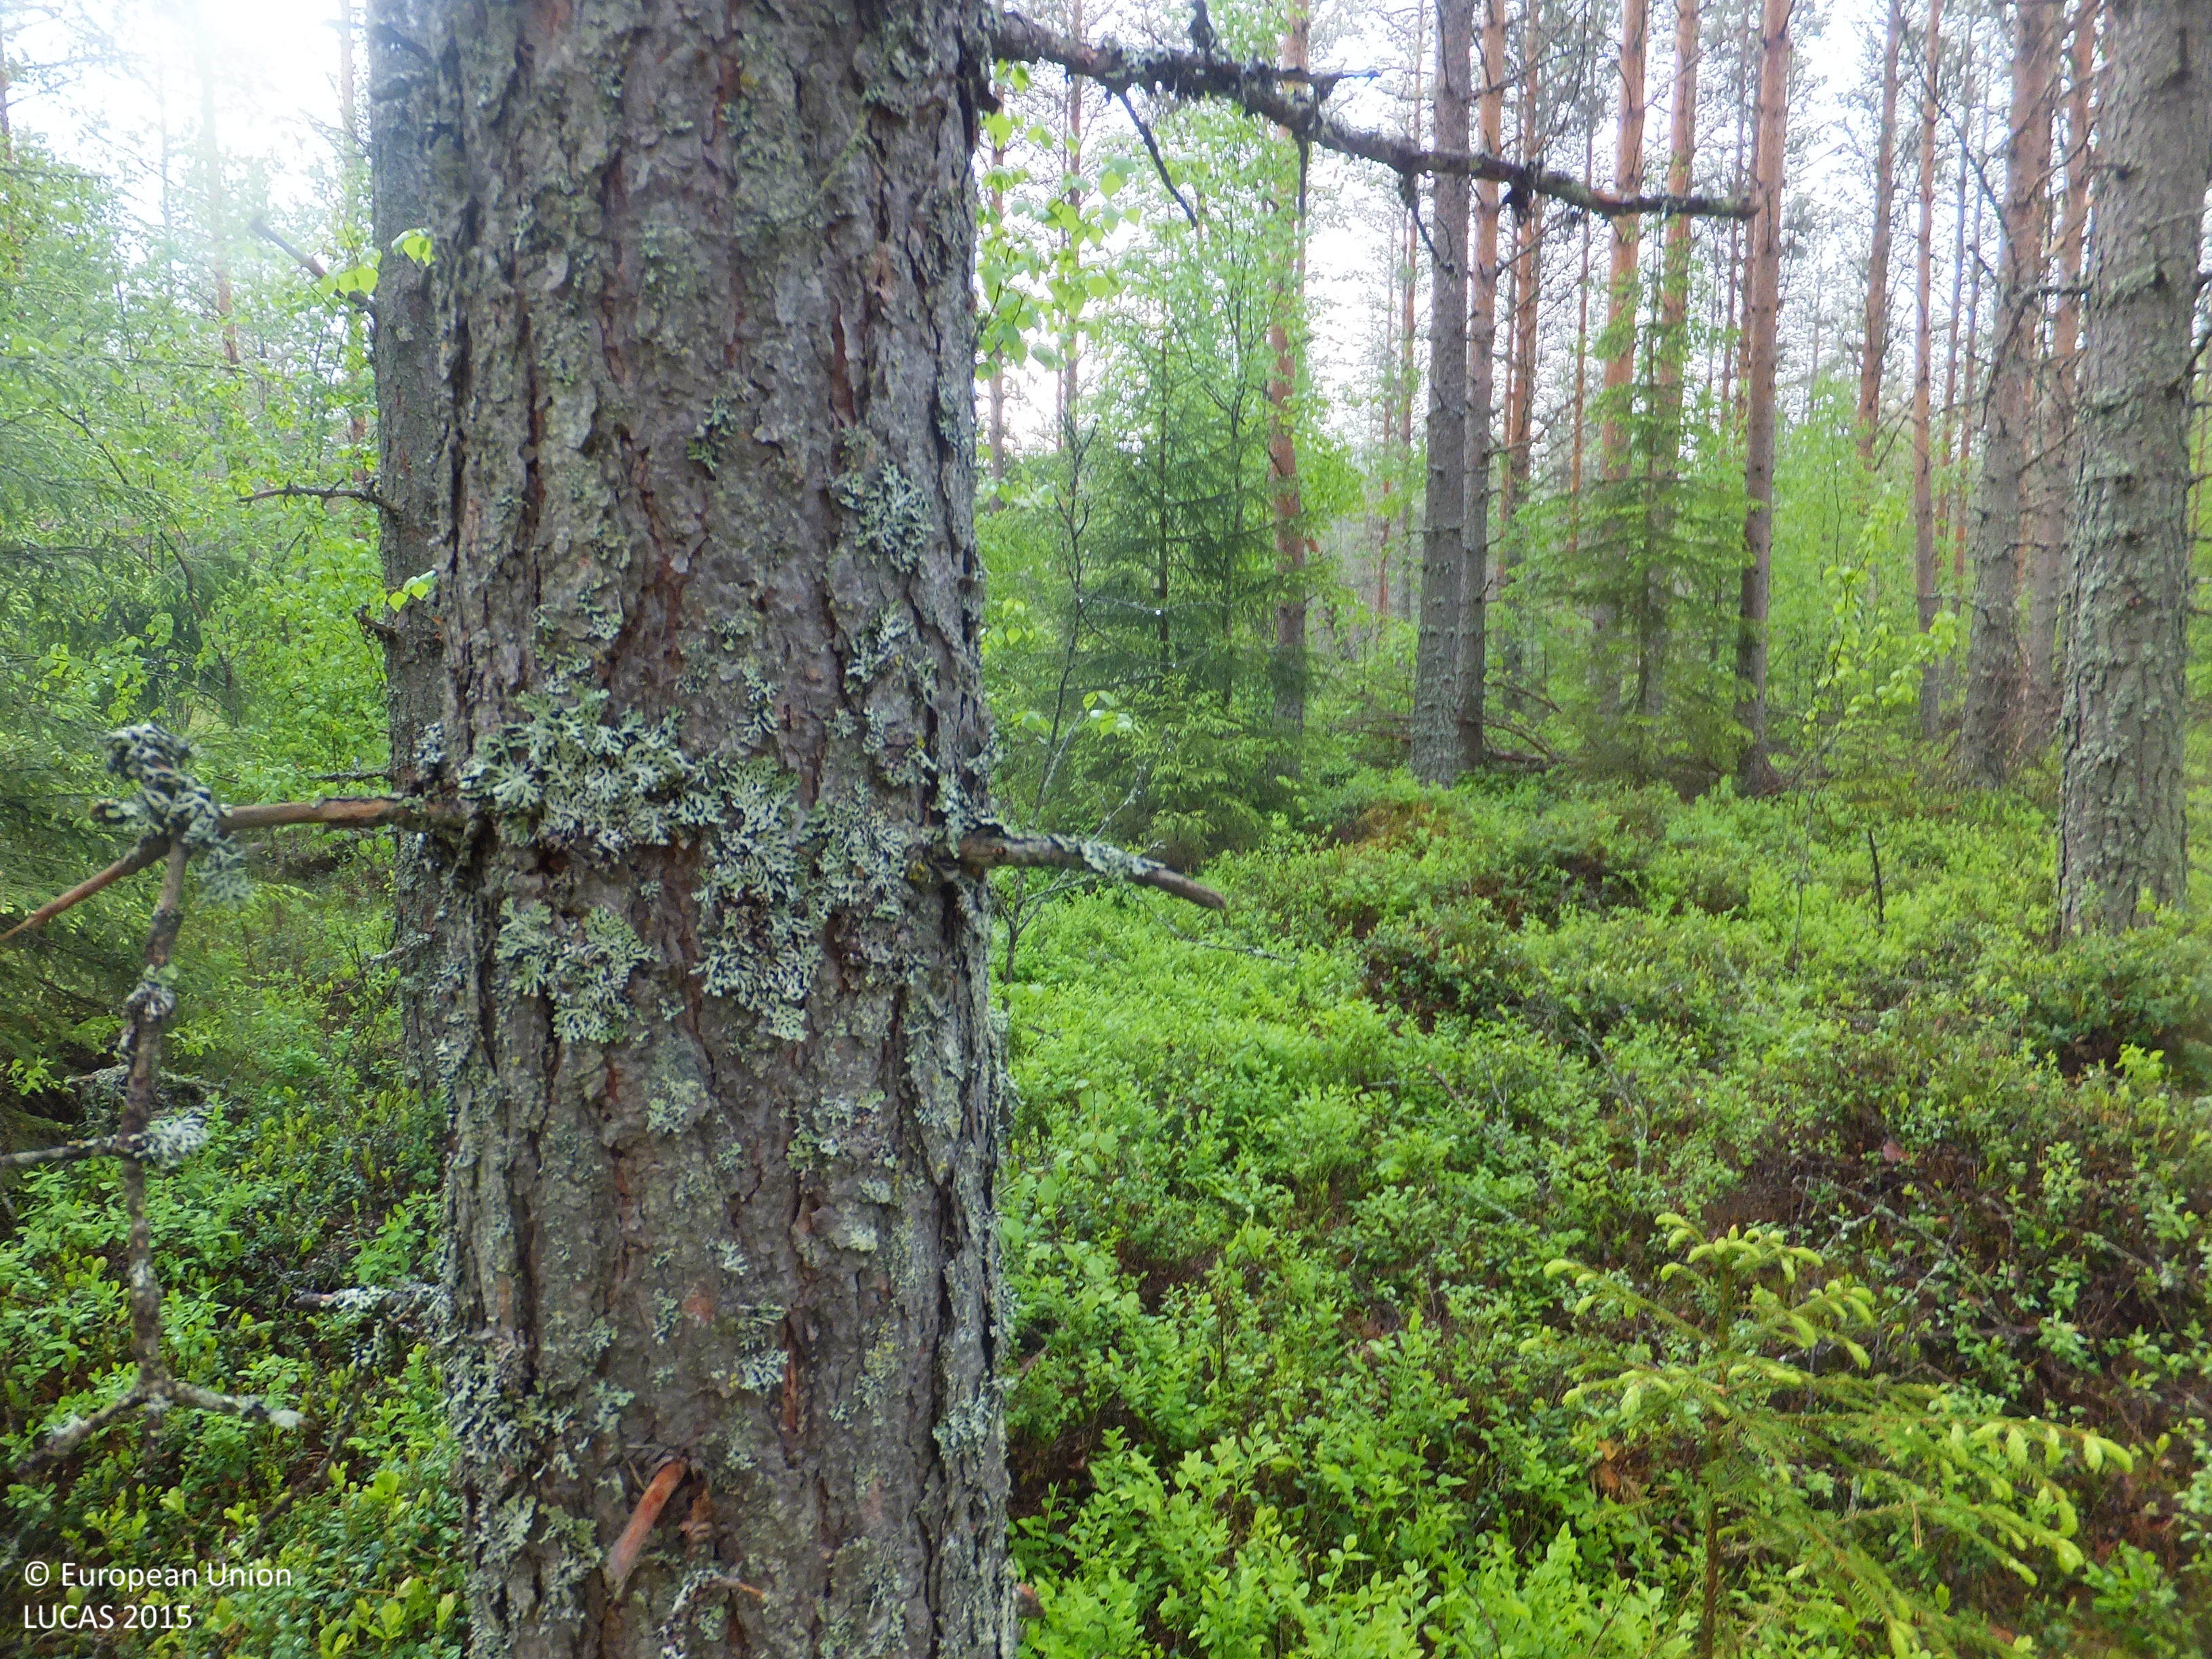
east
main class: Woodland
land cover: Pine dominated coniferous woodland
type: boreal forest
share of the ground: > 75 %
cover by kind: coniferous forest trees 80 %, shrubs 15 %, broadleaved forest trees 5 %
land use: Forestry
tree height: > 5 m
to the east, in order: Pine dominated coniferous woodland; Pine dominated mixed woodland; Ditches and canals; Pine dominated coniferous woodland; Ditches and canals; Pine dominated mixed woodland; Ditches and canals; Pine dominated mixed woodland; Rock outcrops; Other mixed woodland; Pine dominated mixed woodland
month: June
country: FI
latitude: 63.7135
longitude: 24.8387
